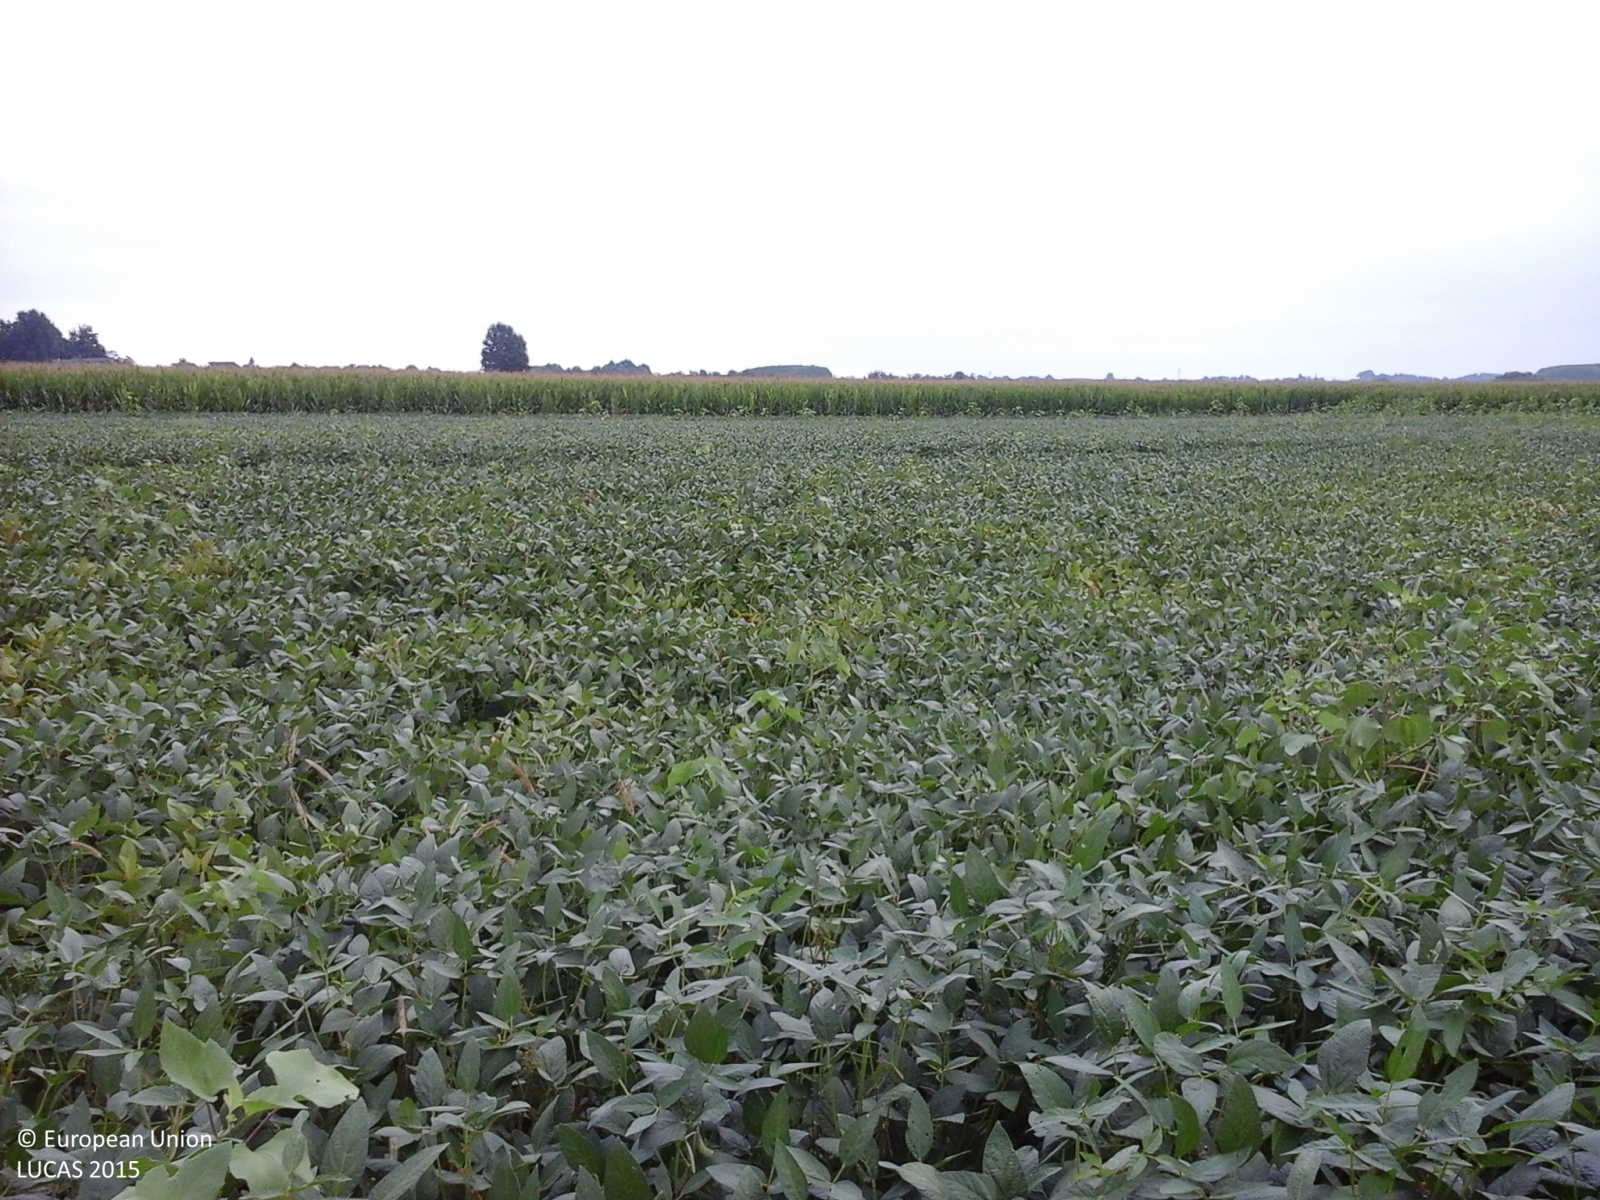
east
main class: Cropland
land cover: Soya
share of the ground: > 75 %
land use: Agriculture (excluding fallow land and kitchen gardens)
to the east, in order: Soya; Maize; Grass margins; Temporary grasslands
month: July
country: IT
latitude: 44.7950
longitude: 7.7416
